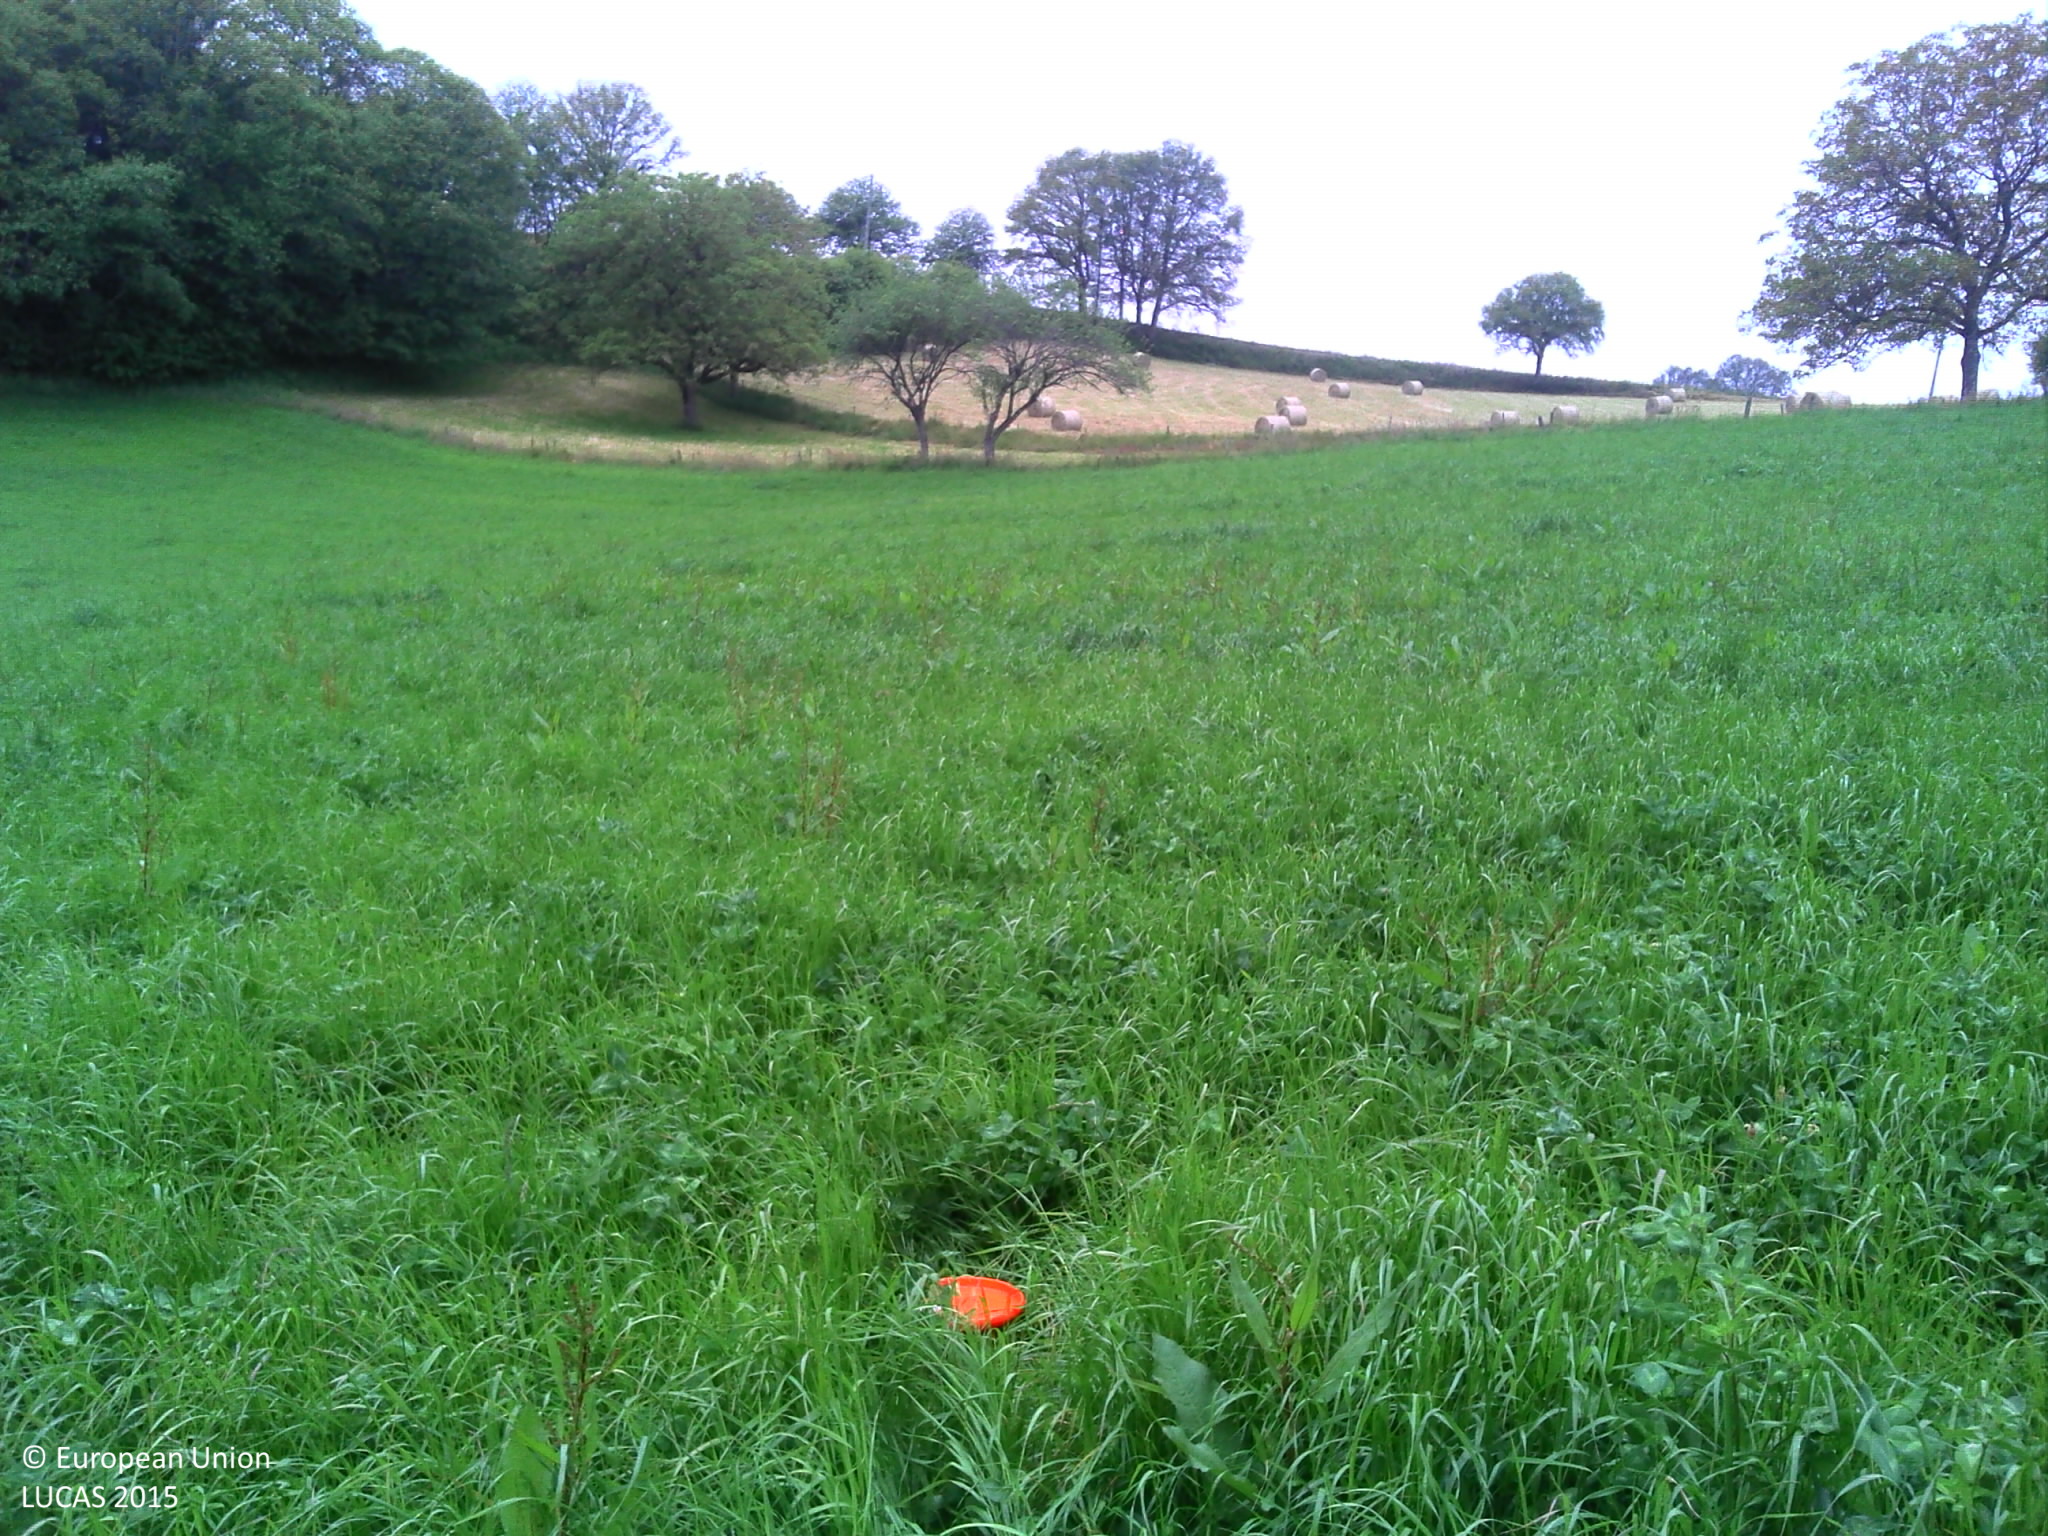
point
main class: Cropland
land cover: Temporary grasslands
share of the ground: > 75 %
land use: Agriculture (excluding fallow land and kitchen gardens)
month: June
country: FR
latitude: 44.7283
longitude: 1.9817
